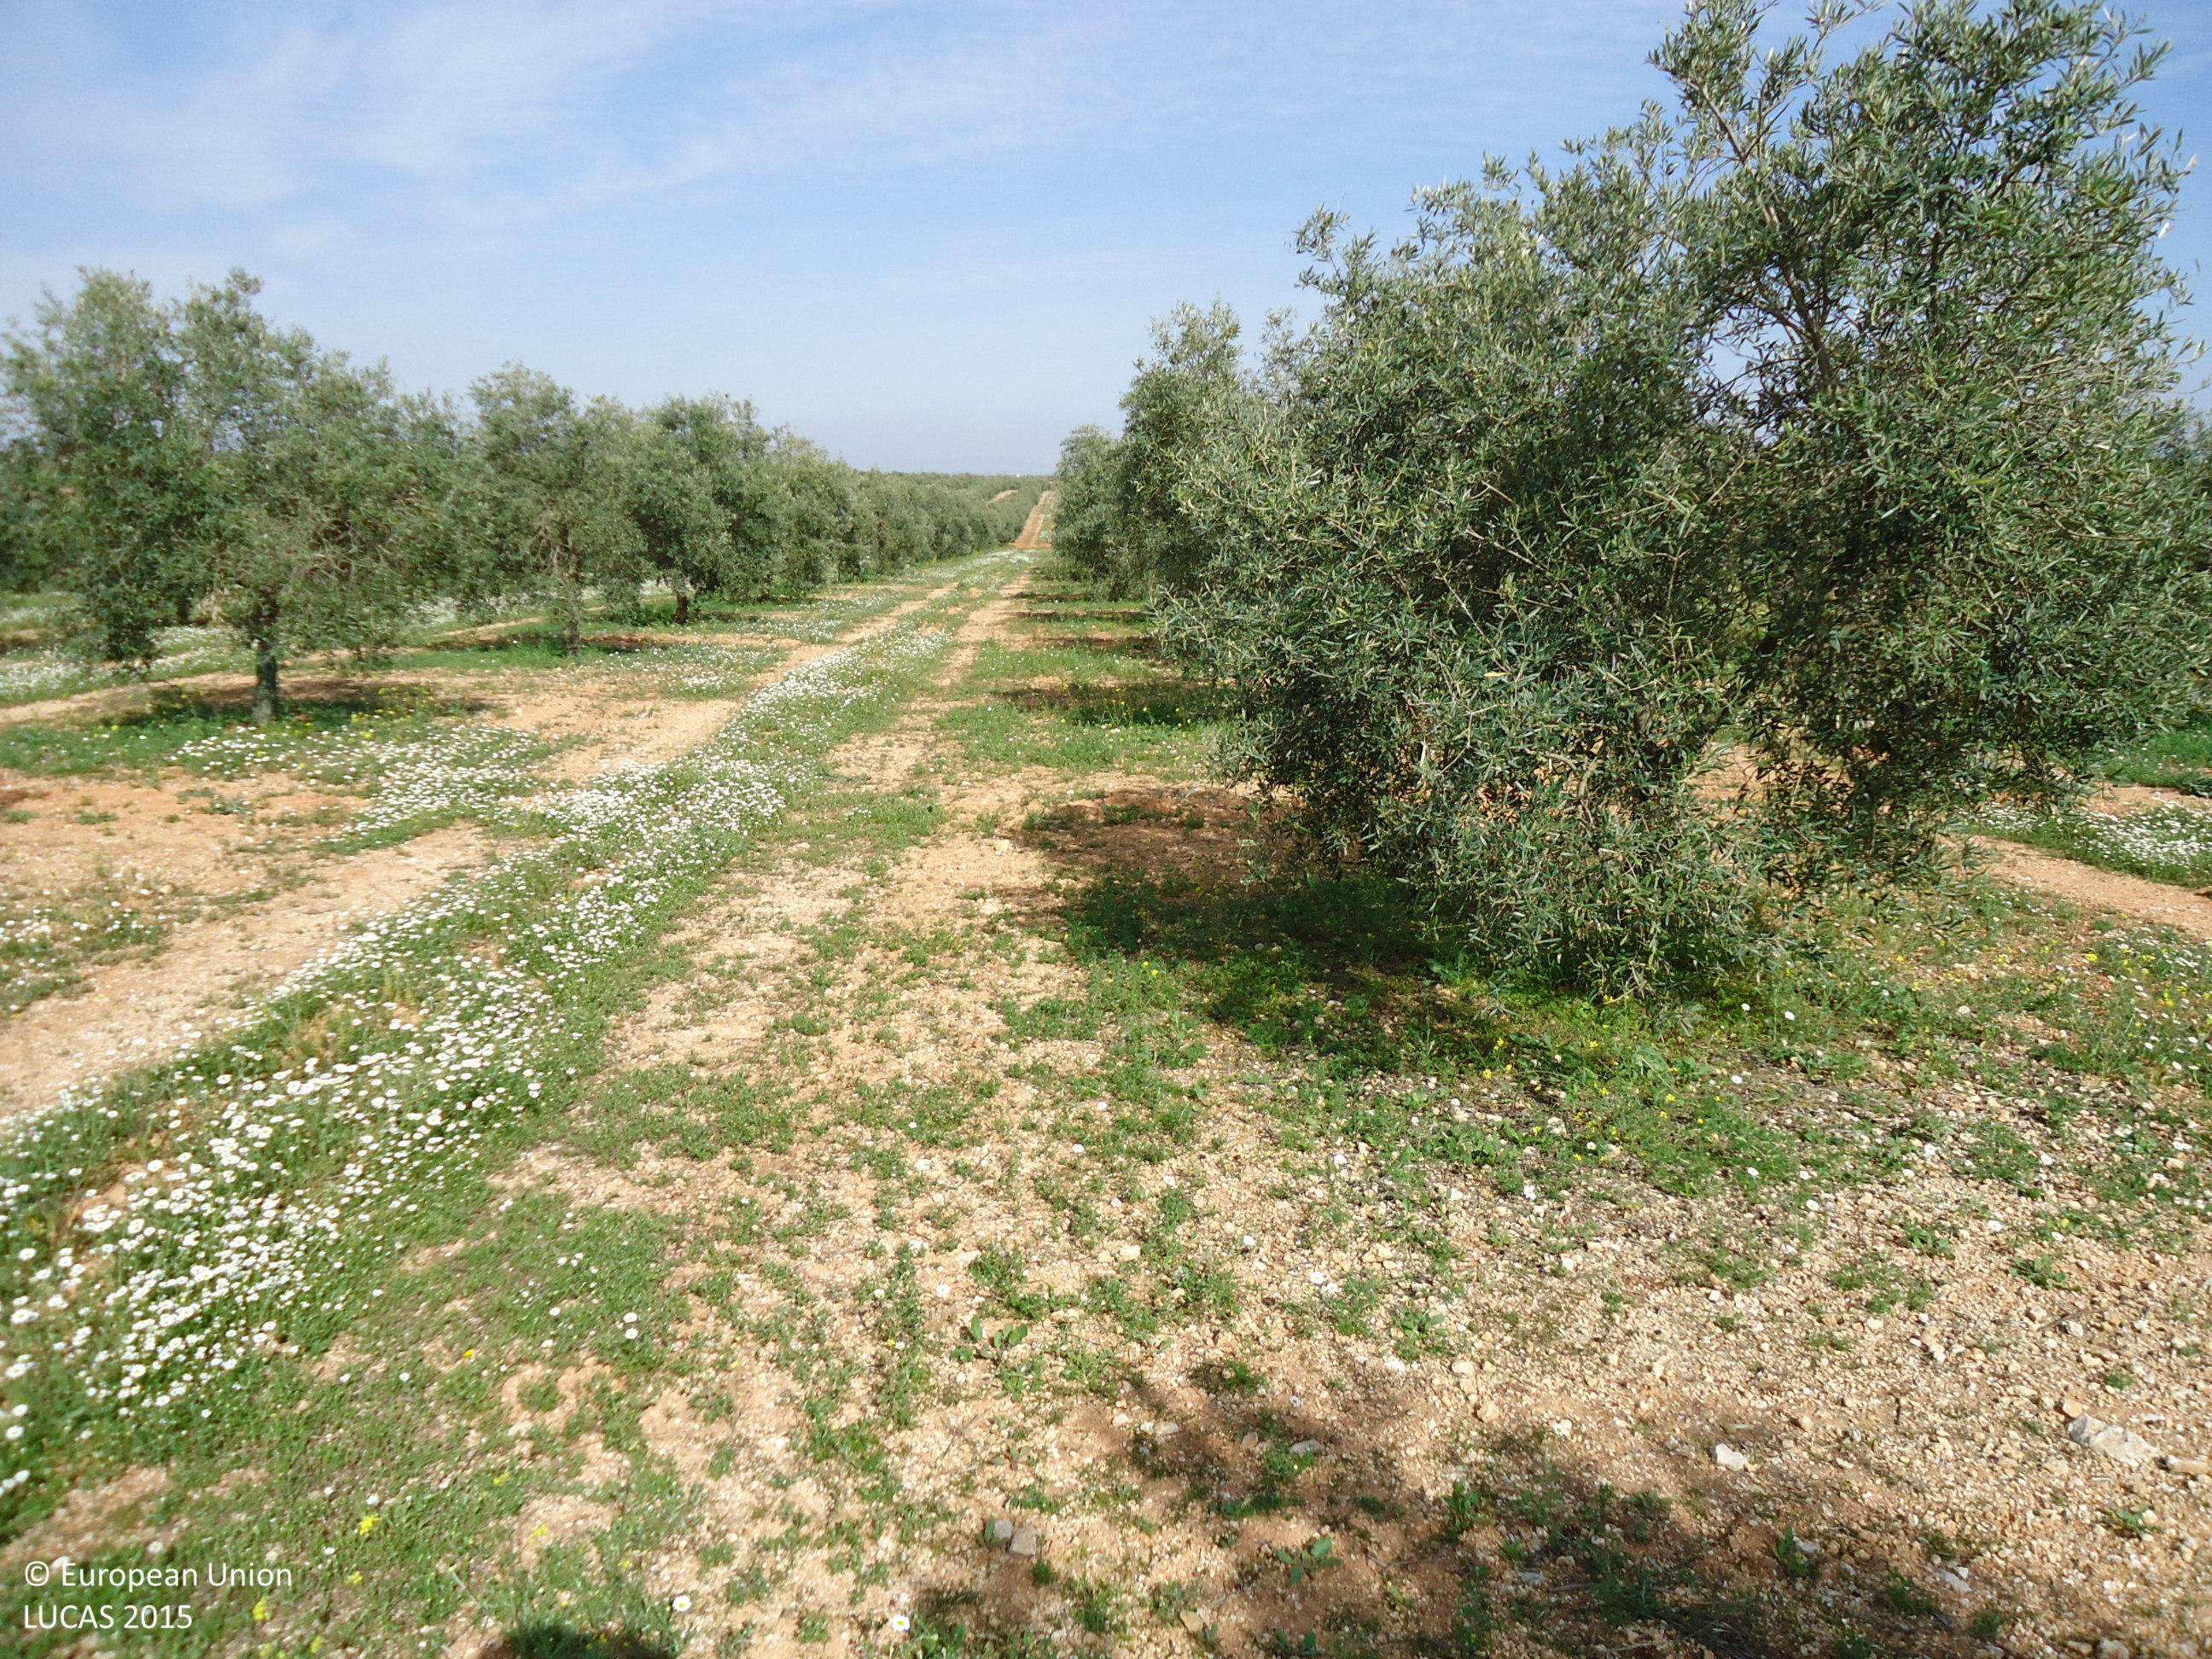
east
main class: Cropland
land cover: Olive groves
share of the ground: 25 - 50 %
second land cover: Spontaneously vegetated surfaces
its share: > 75 %
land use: Agriculture (excluding fallow land and kitchen gardens)
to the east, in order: Olive groves; Spontaneously vegetated surfaces
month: April
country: ES
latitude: 37.1303
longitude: -4.8264
